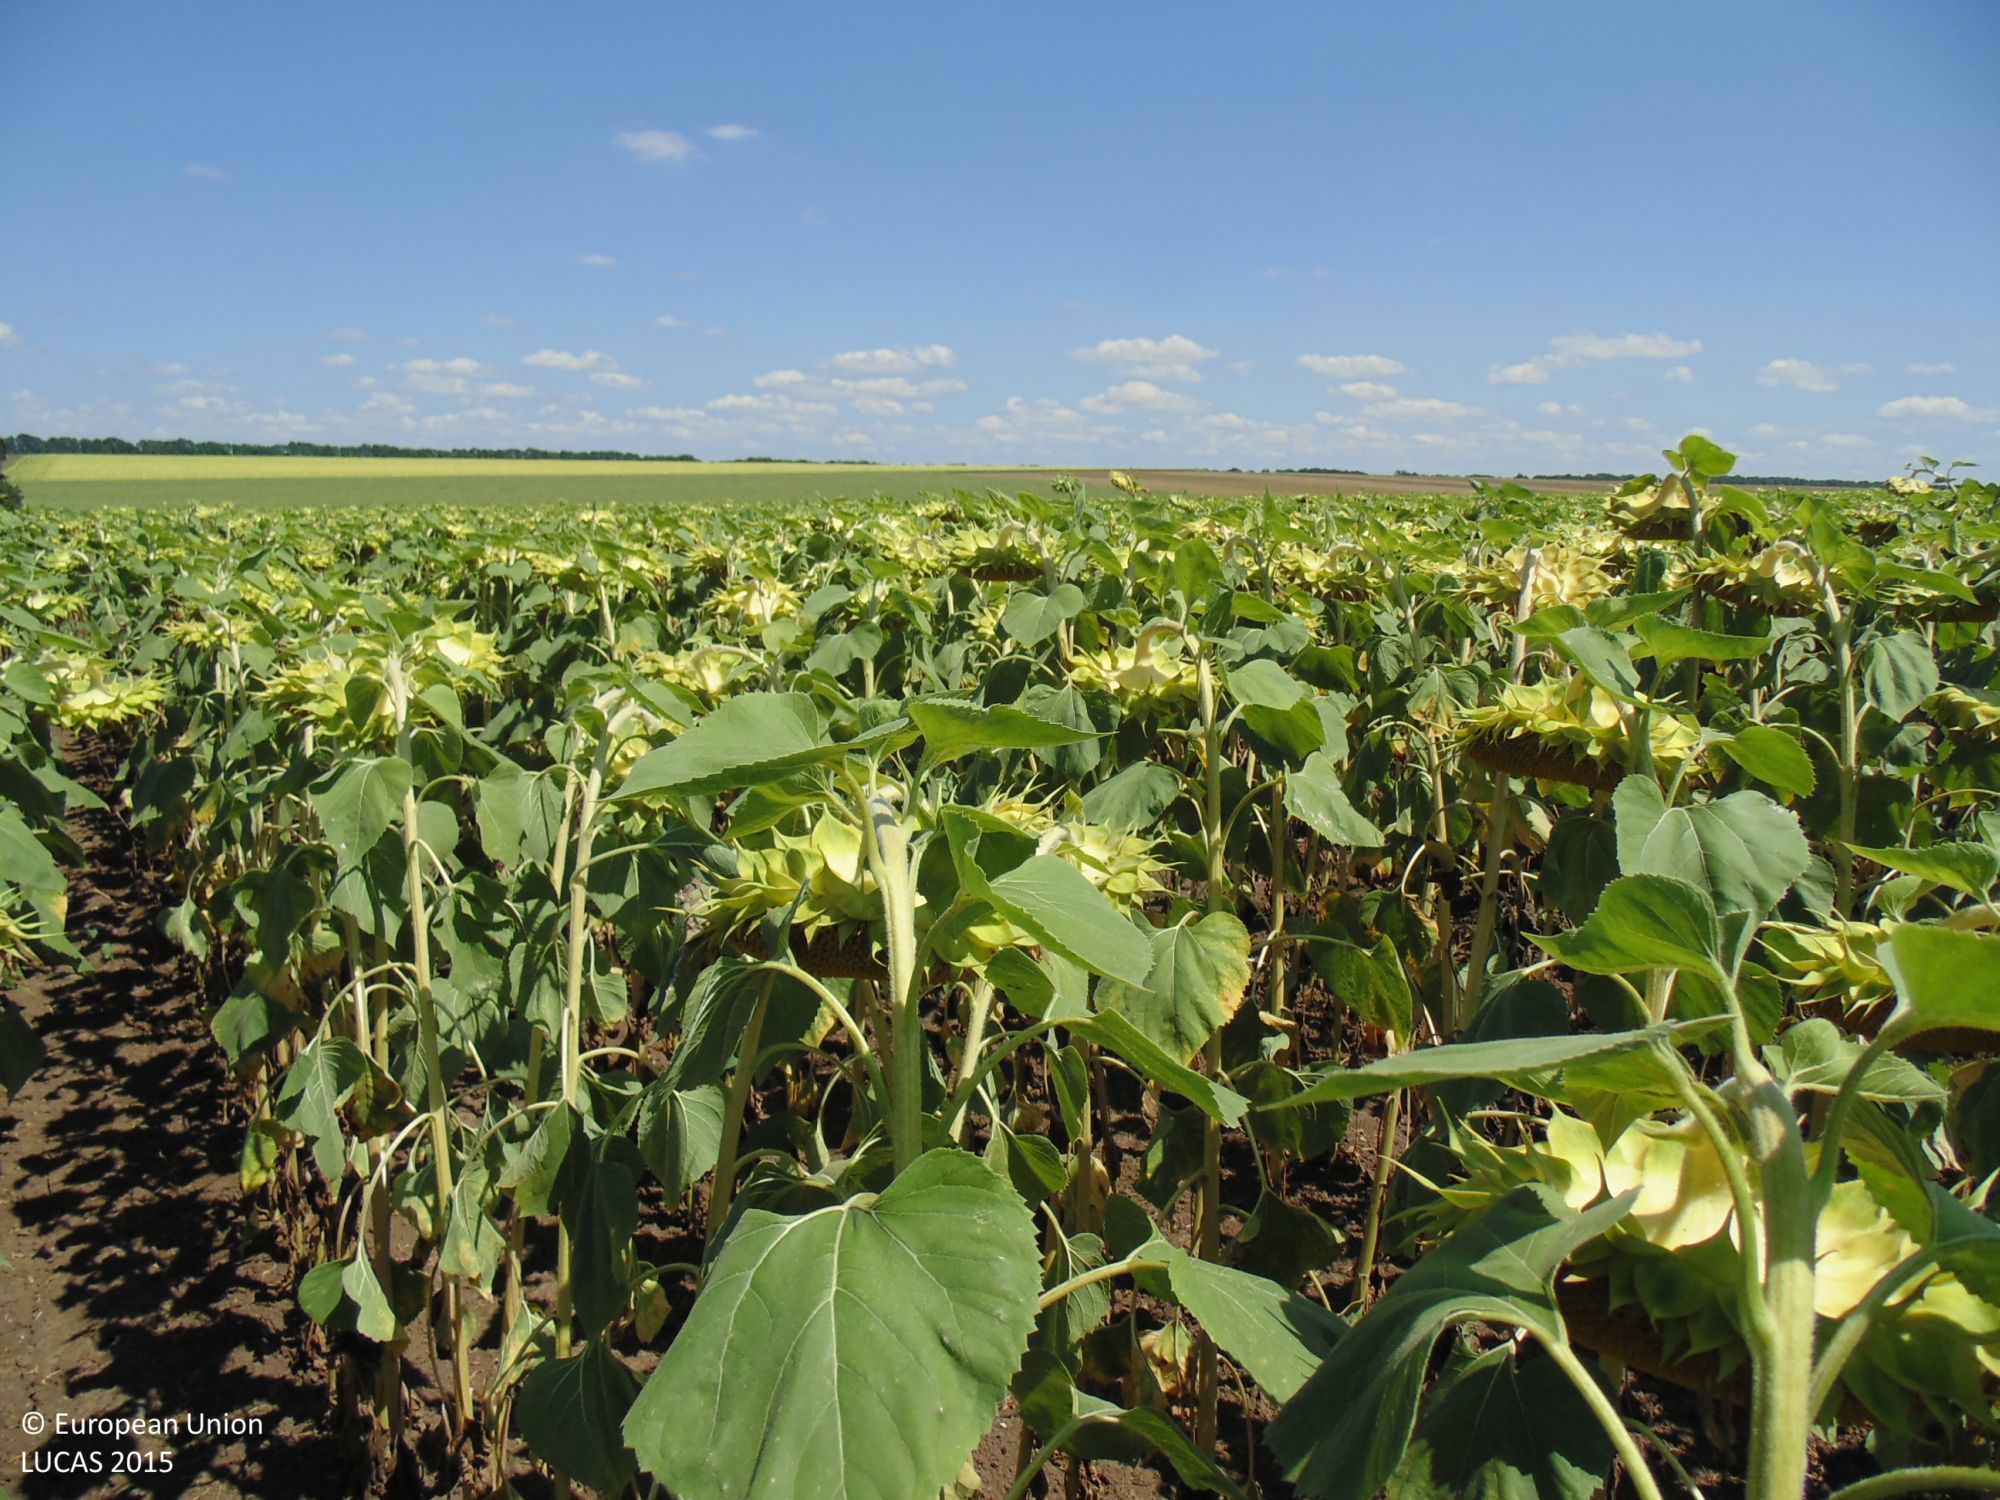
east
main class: Cropland
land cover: Sunflower
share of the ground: > 75 %
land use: Agriculture (excluding fallow land and kitchen gardens)
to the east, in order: Sunflower
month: August
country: BG
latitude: 43.6091
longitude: 28.1029
